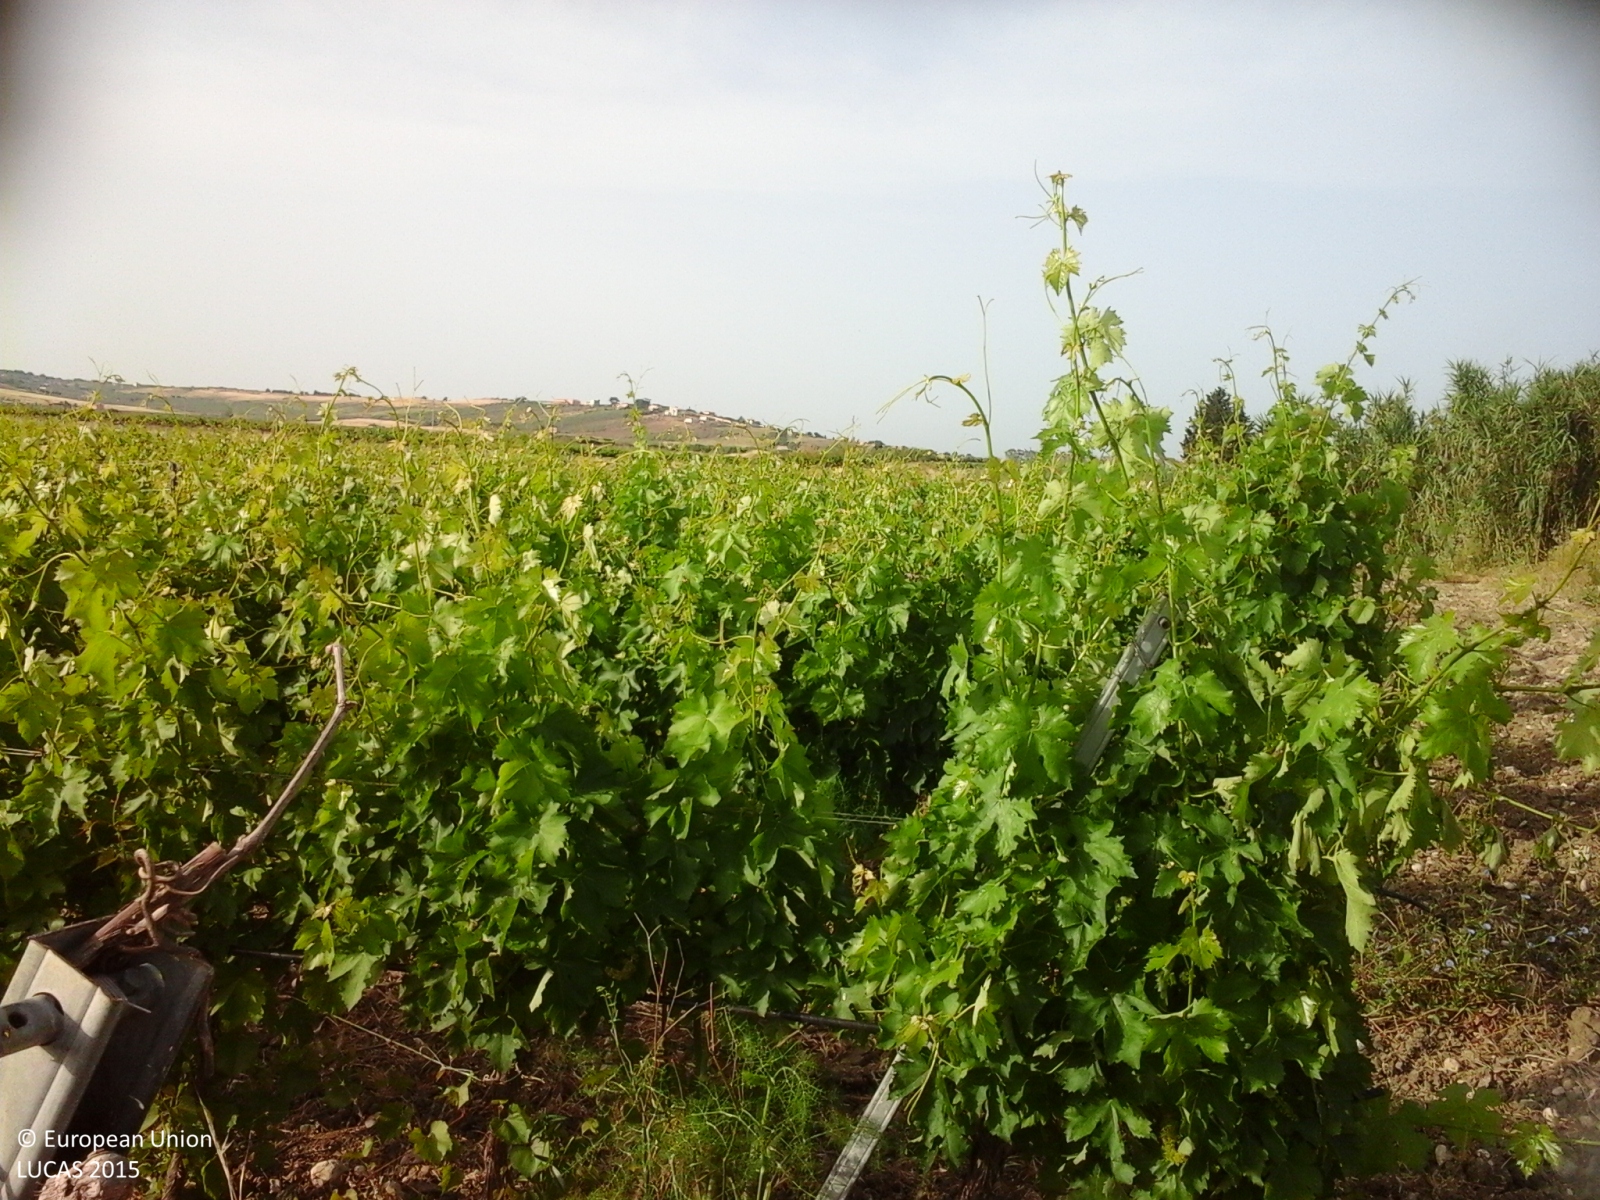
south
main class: Cropland
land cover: Vineyards
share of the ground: 25 - 50 %
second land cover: Other bare soil
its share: > 75 %
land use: Agriculture (excluding fallow land and kitchen gardens)
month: May
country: IT
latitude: 37.5549
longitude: 12.9994
